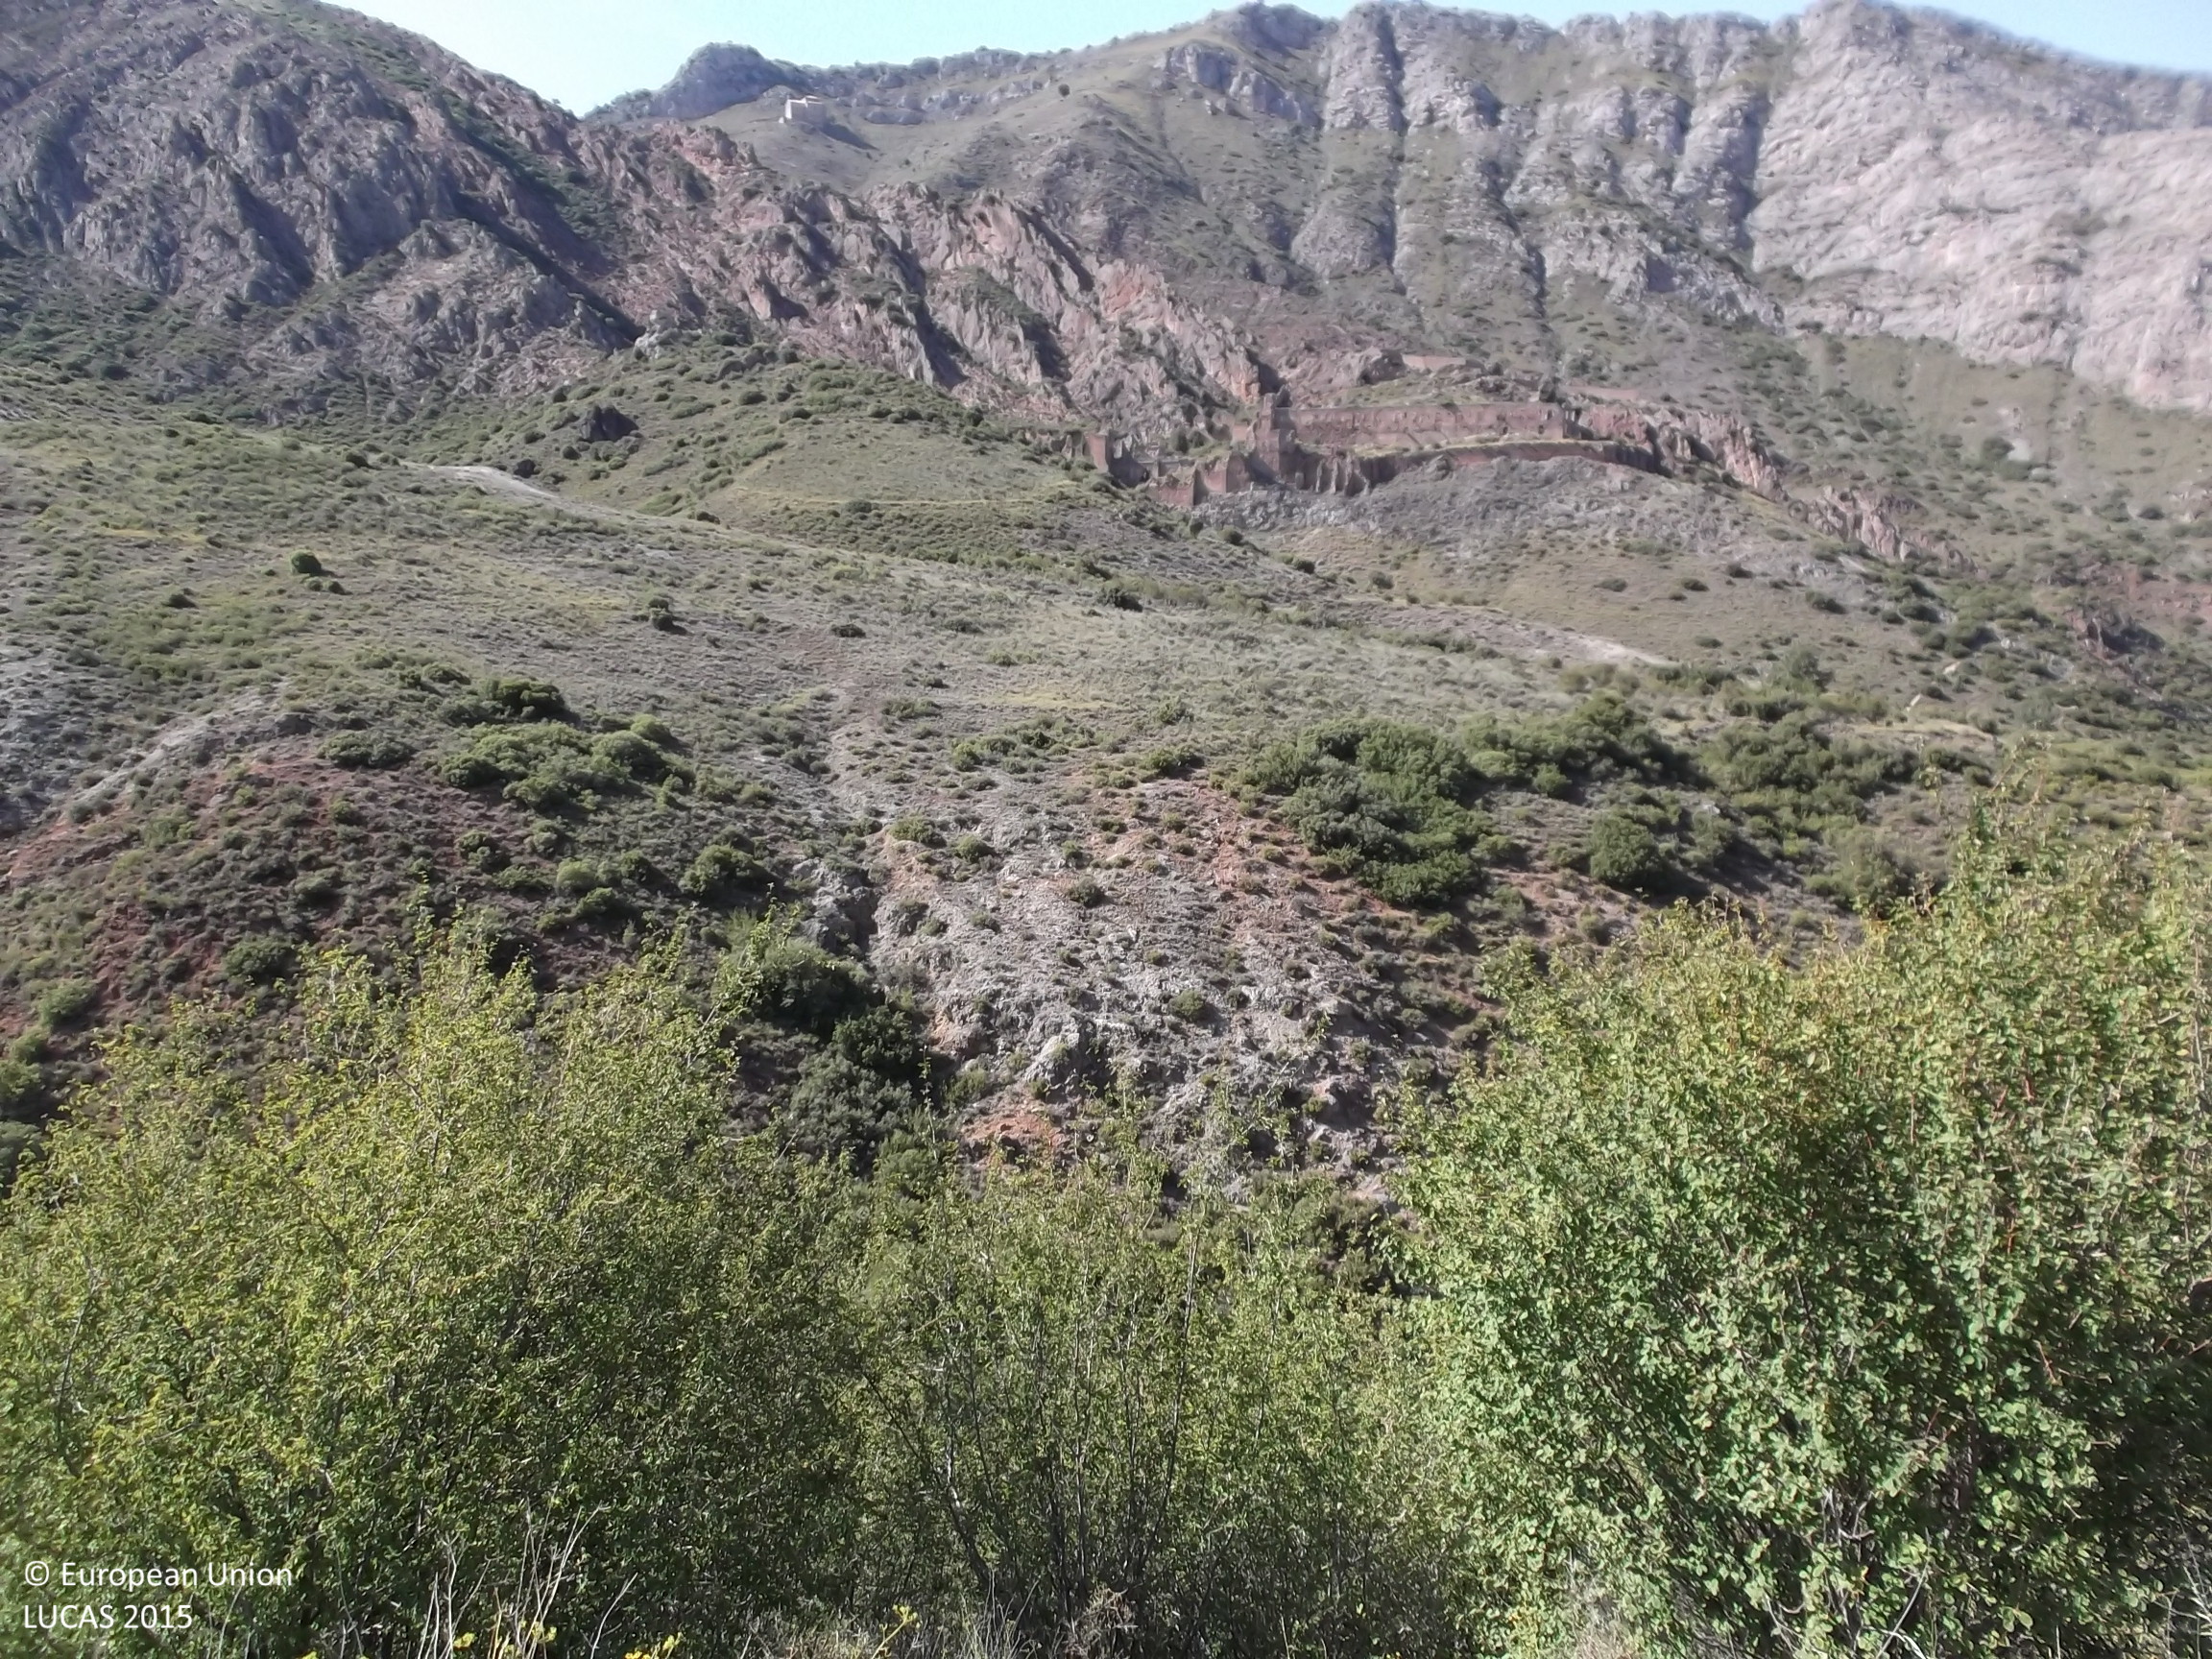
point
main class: Shrubland
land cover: Shrubland with sparse tree cover
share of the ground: 50 - 75 %
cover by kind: shrubs 50 %, herbaceous plants 30 %, unconsolidated bare surface 10 %, broadleaved forest trees 5 %, lichens and mosses 5 %
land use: Semi-natural and natural areas not in use
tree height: < 5 m
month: August
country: ES
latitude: 42.3436
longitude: -2.4121
